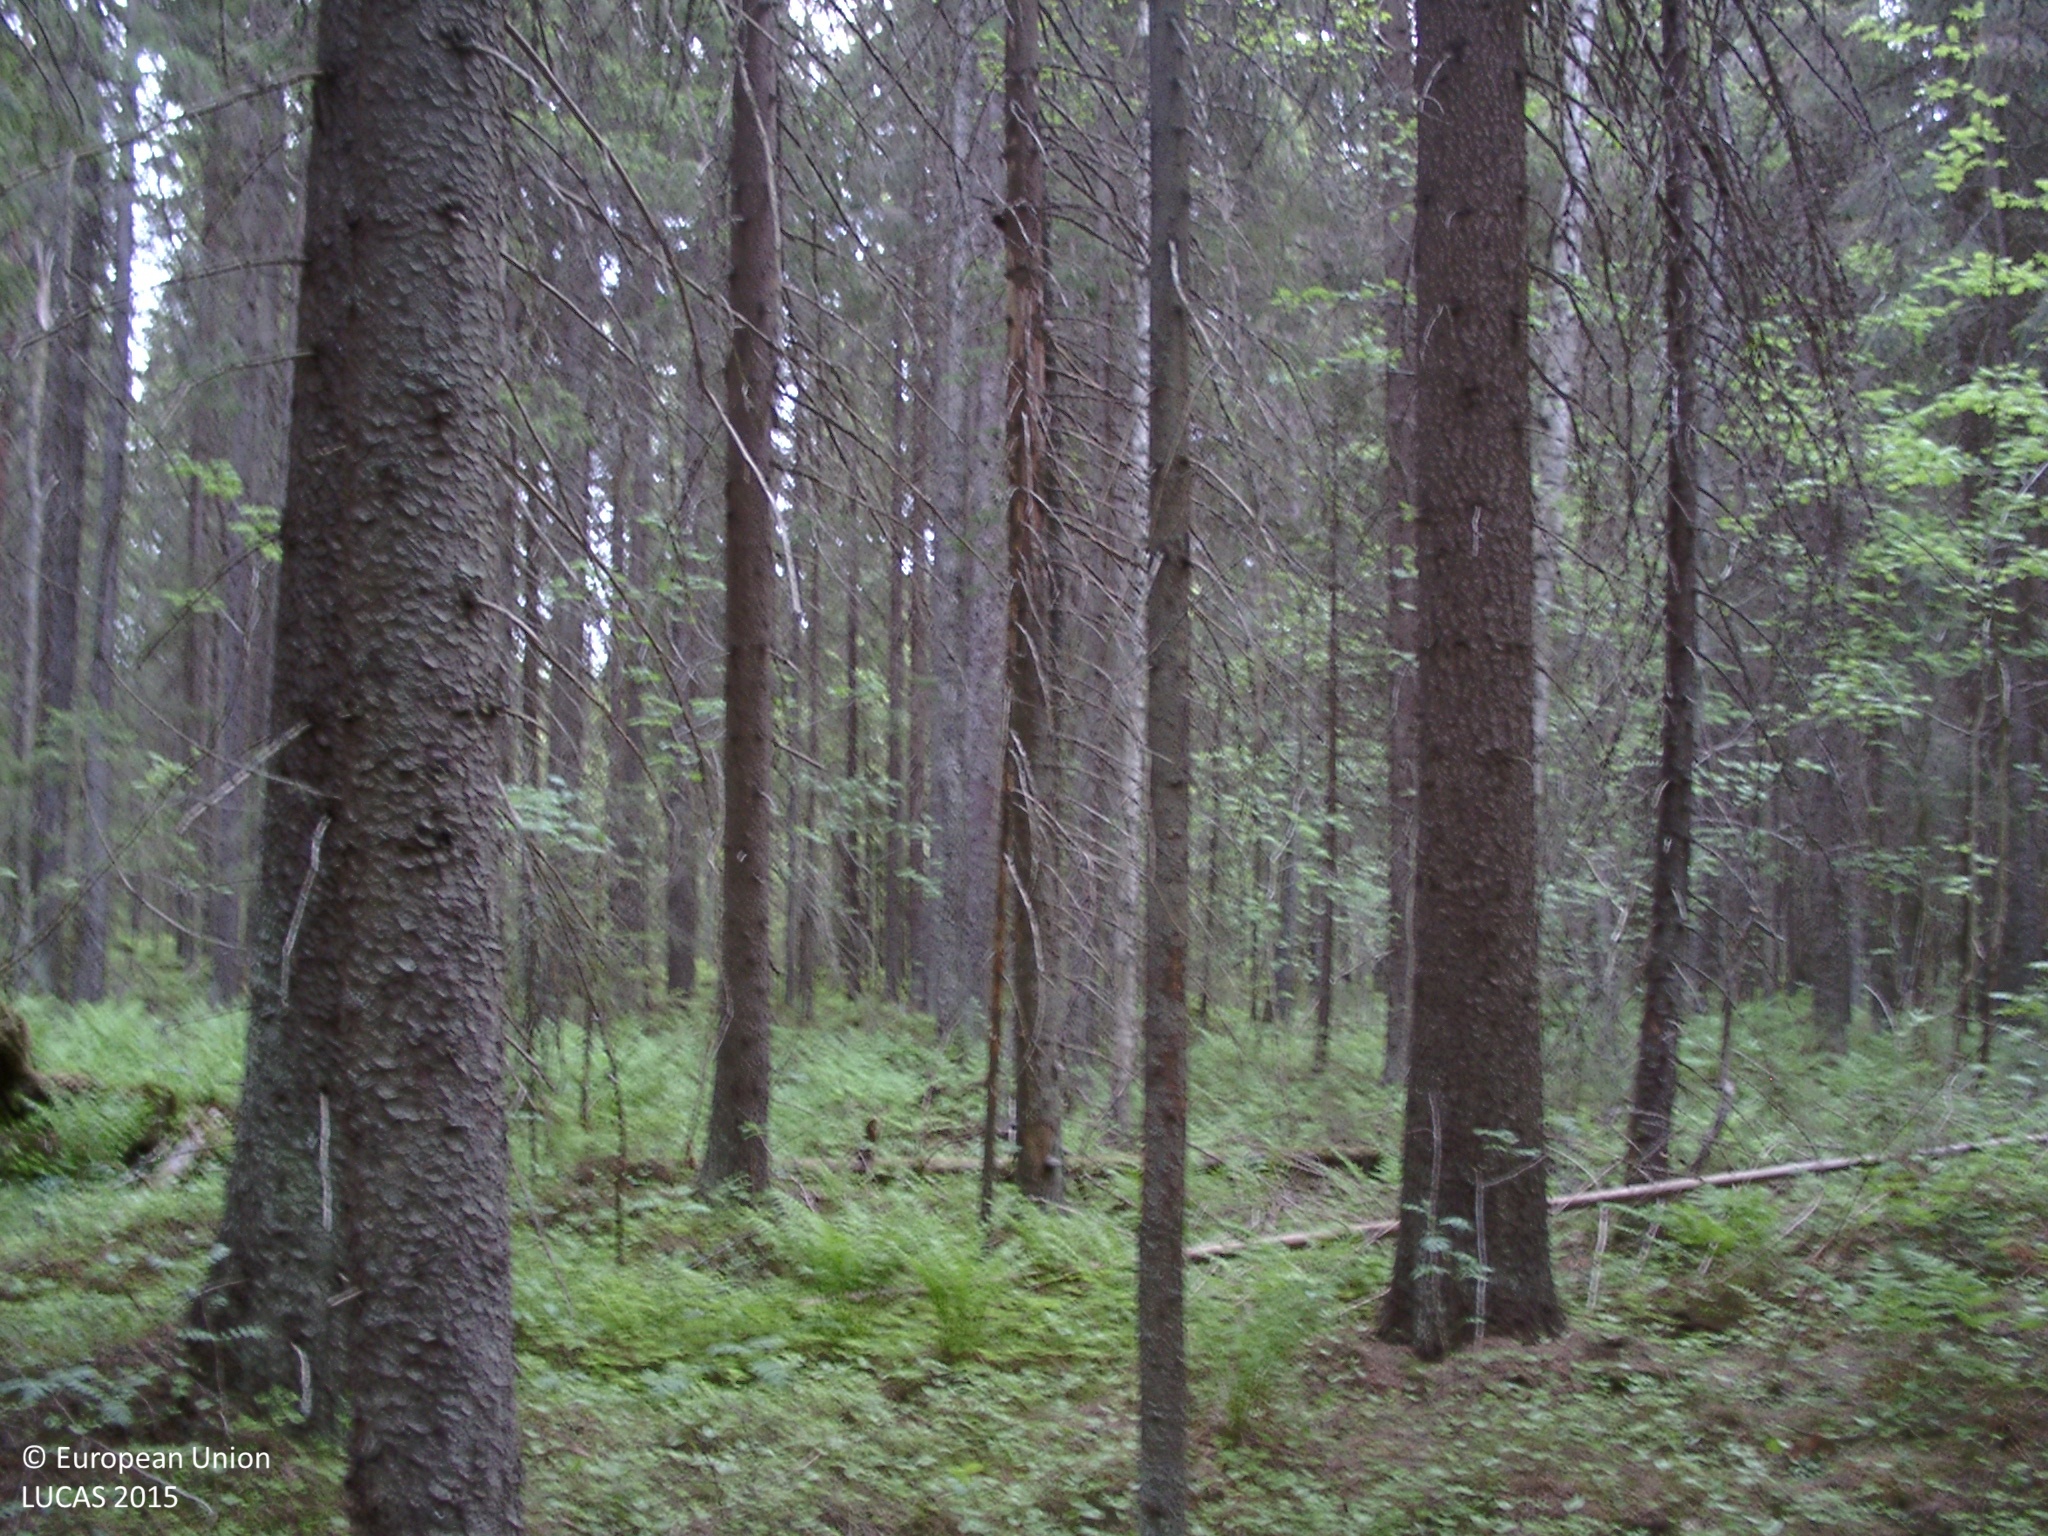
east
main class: Woodland
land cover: Spruce dominated coniferous woodland
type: boreal forest
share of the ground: 50 - 75 %
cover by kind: coniferous forest trees 65 %, lichens and mosses 15 %, shrubs 10 %, broadleaved forest trees 5 %, herbaceous plants 5 %
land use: Forestry
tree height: > 5 m
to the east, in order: Spruce dominated coniferous woodland; Other mixed woodland; Ditches and canals; Other mixed woodland; Ditches and canals; Spruce dominated mixed woodland; Spruce dominated coniferous woodland
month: June
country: FI
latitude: 62.0723
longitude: 25.5627
